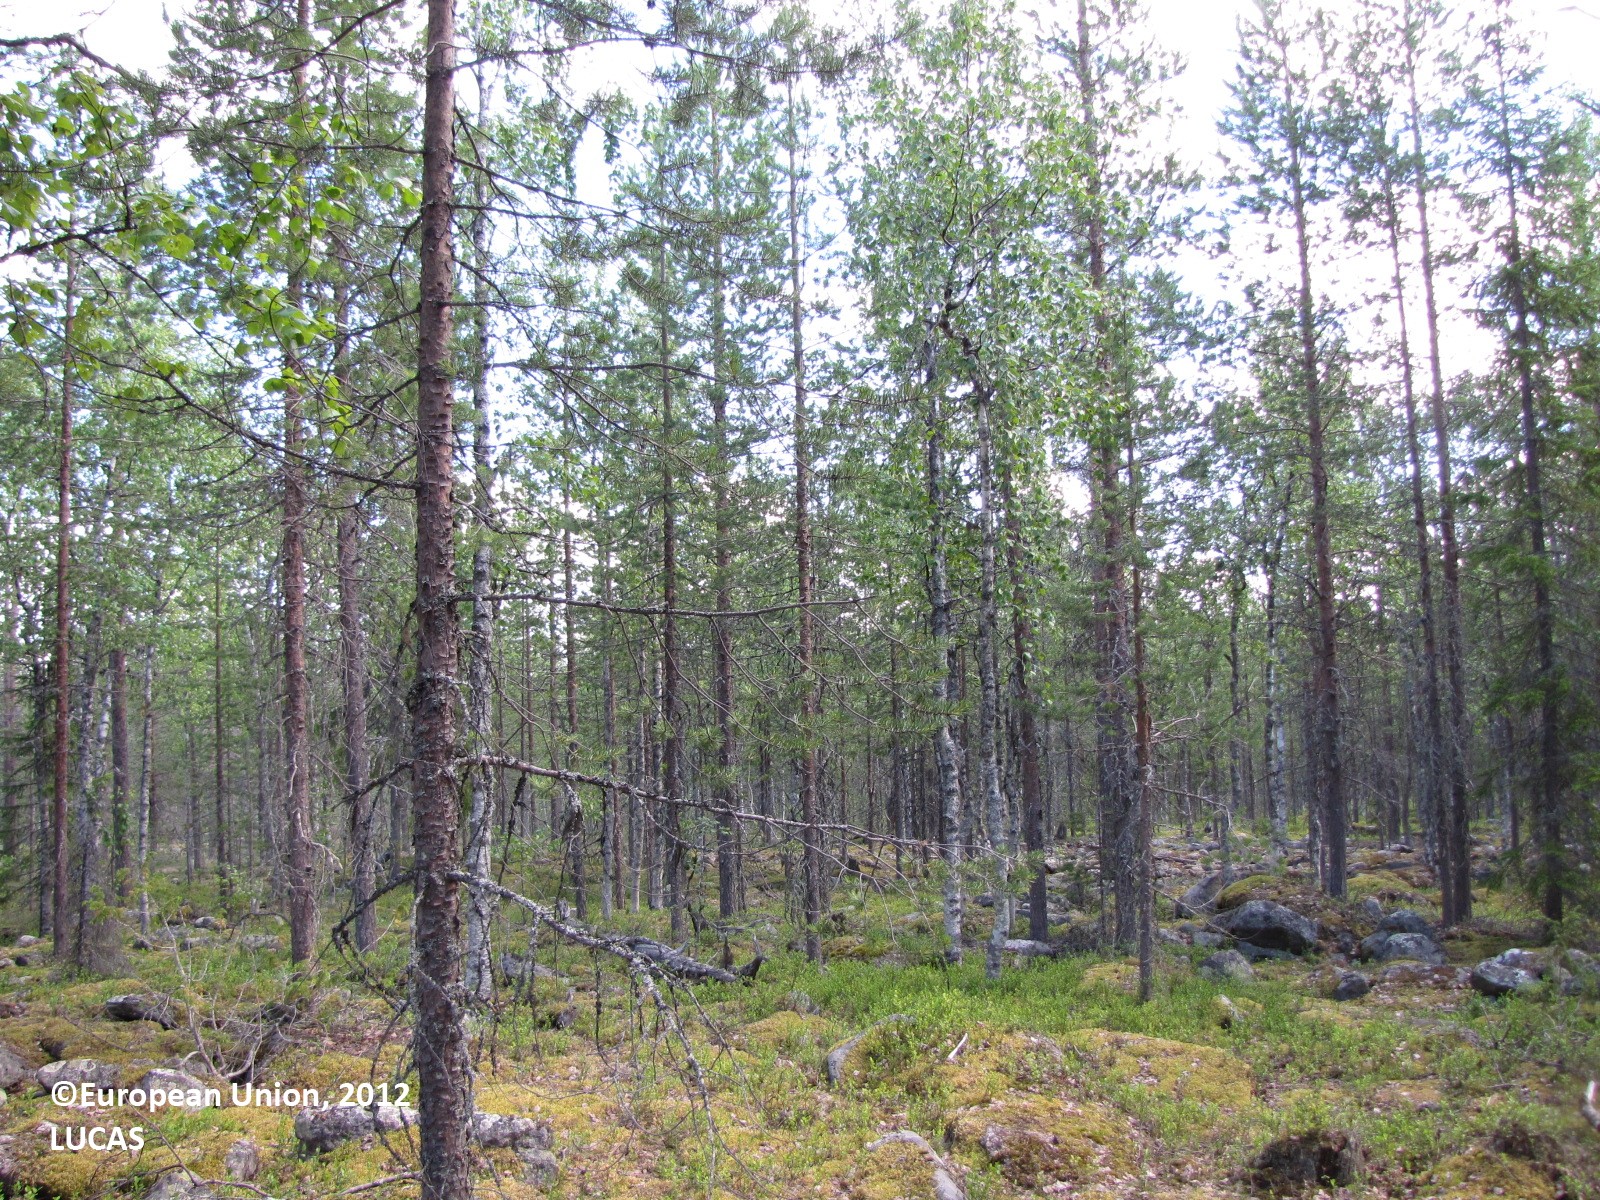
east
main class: Woodland
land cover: Pine dominated mixed woodland
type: boreal forest
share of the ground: 50 - 75 %
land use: Forestry
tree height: > 5 m
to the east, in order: Pine dominated mixed woodland; Tracks; Pine dominated mixed woodland
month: July
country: FI
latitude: 66.5139
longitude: 24.5033
